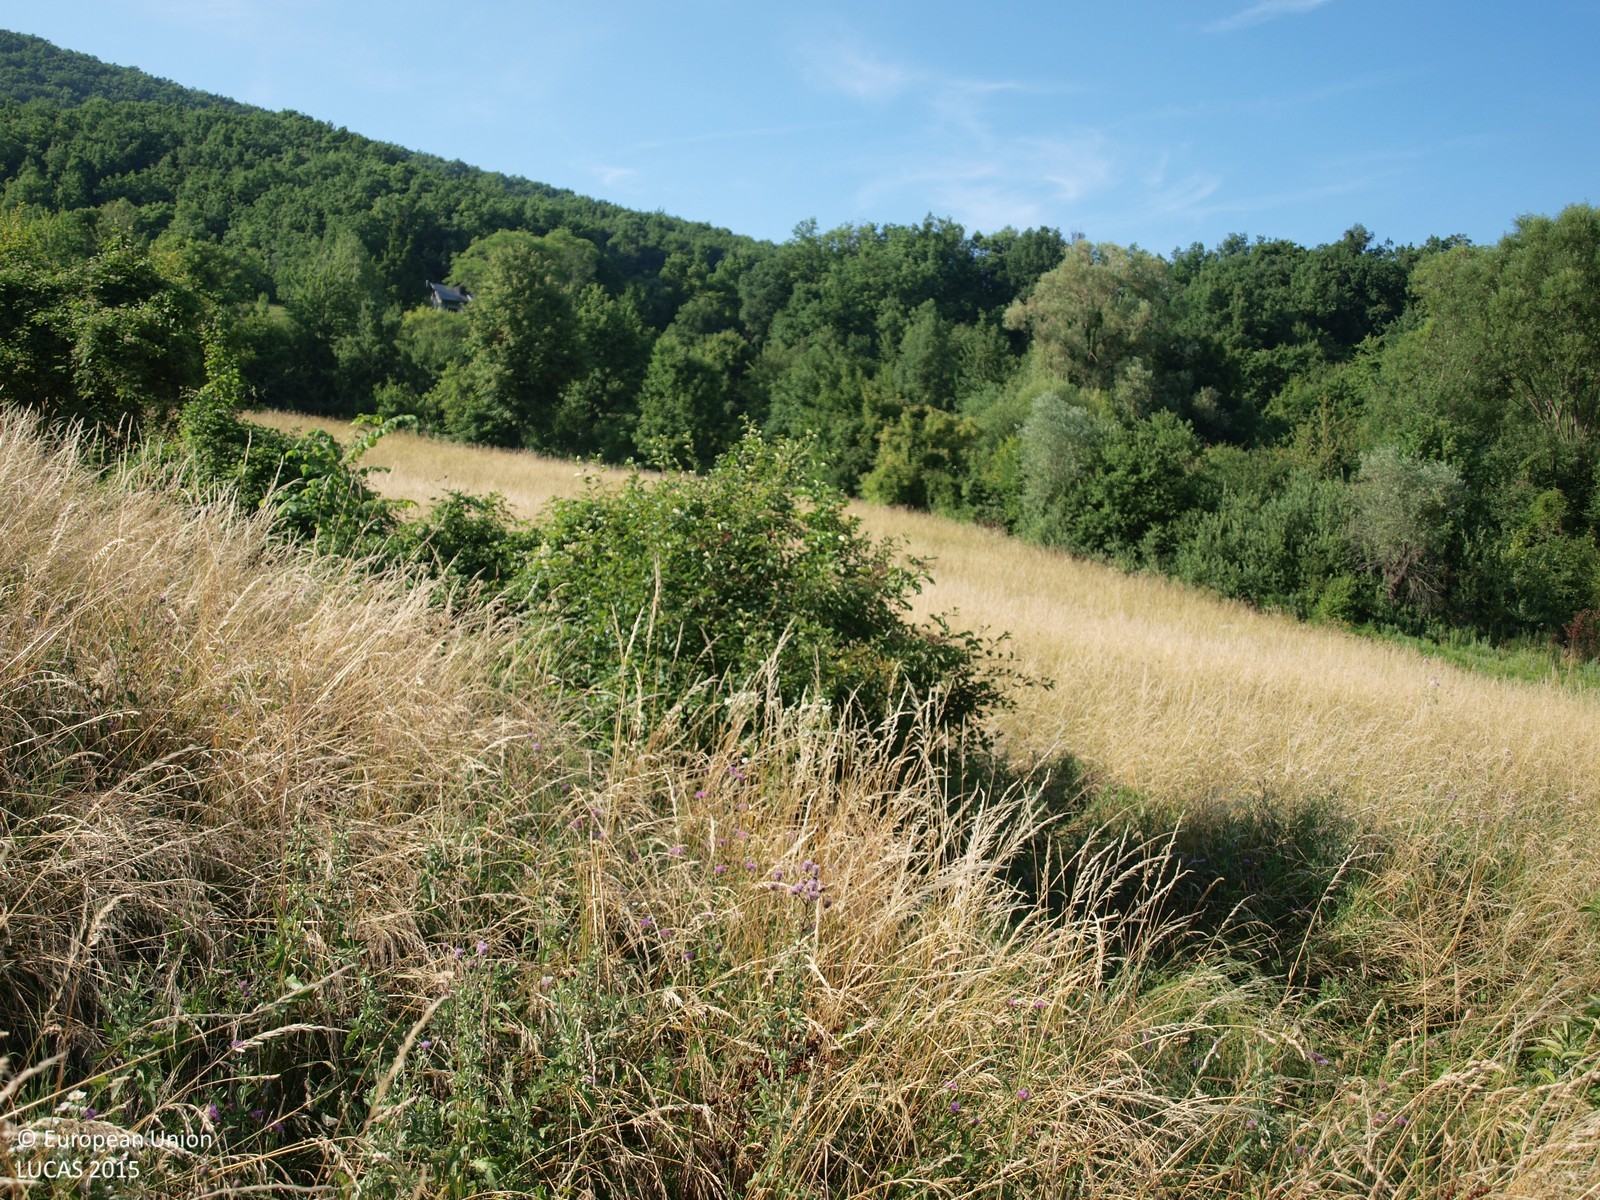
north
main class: Grassland
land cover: Grassland without tree/shrub cover
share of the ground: > 75 %
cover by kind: herbaceous plants 100 %
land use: Agriculture (excluding fallow land and kitchen gardens)
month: July
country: HR
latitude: 45.7303
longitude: 15.6897
